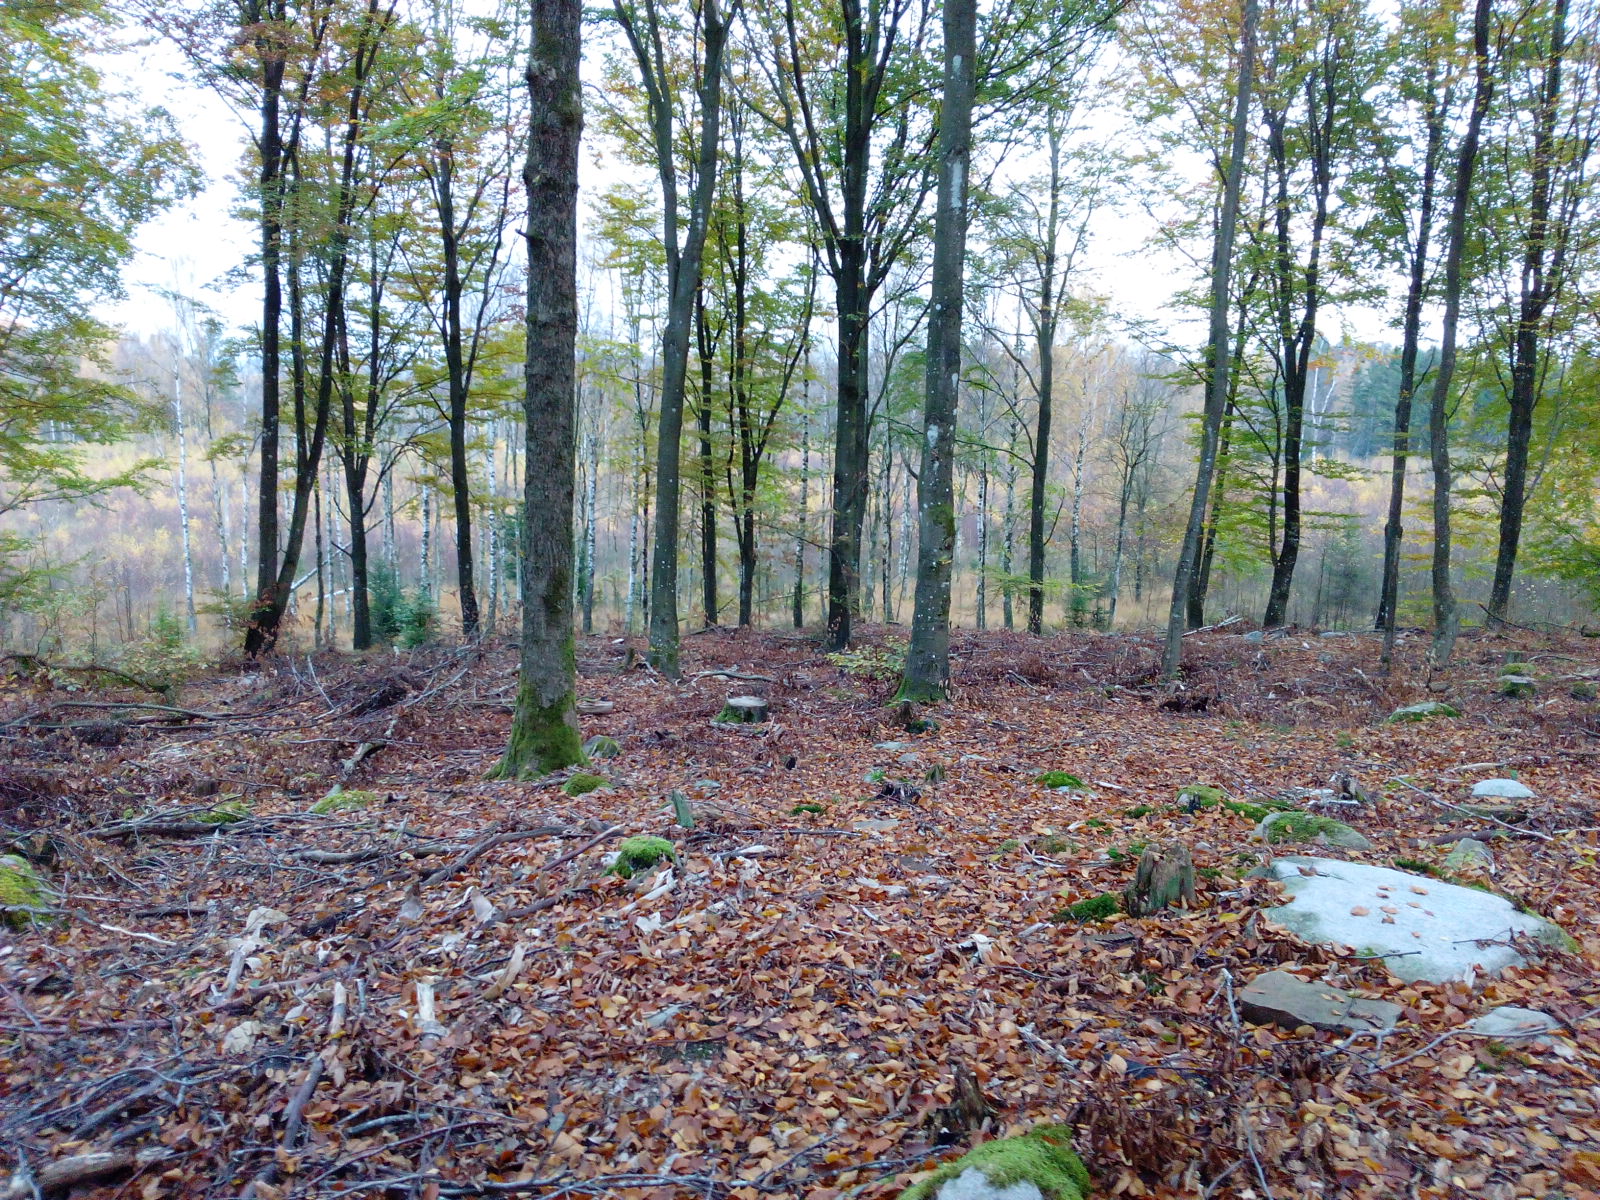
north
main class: Woodland
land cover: Broadleaved woodland
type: beech forest
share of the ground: 50 - 75 %
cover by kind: broadleaved forest trees 60 %, herbaceous plants 40 %
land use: Forestry
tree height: > 5 m
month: October
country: SE
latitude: 56.5086
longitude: 13.1655
